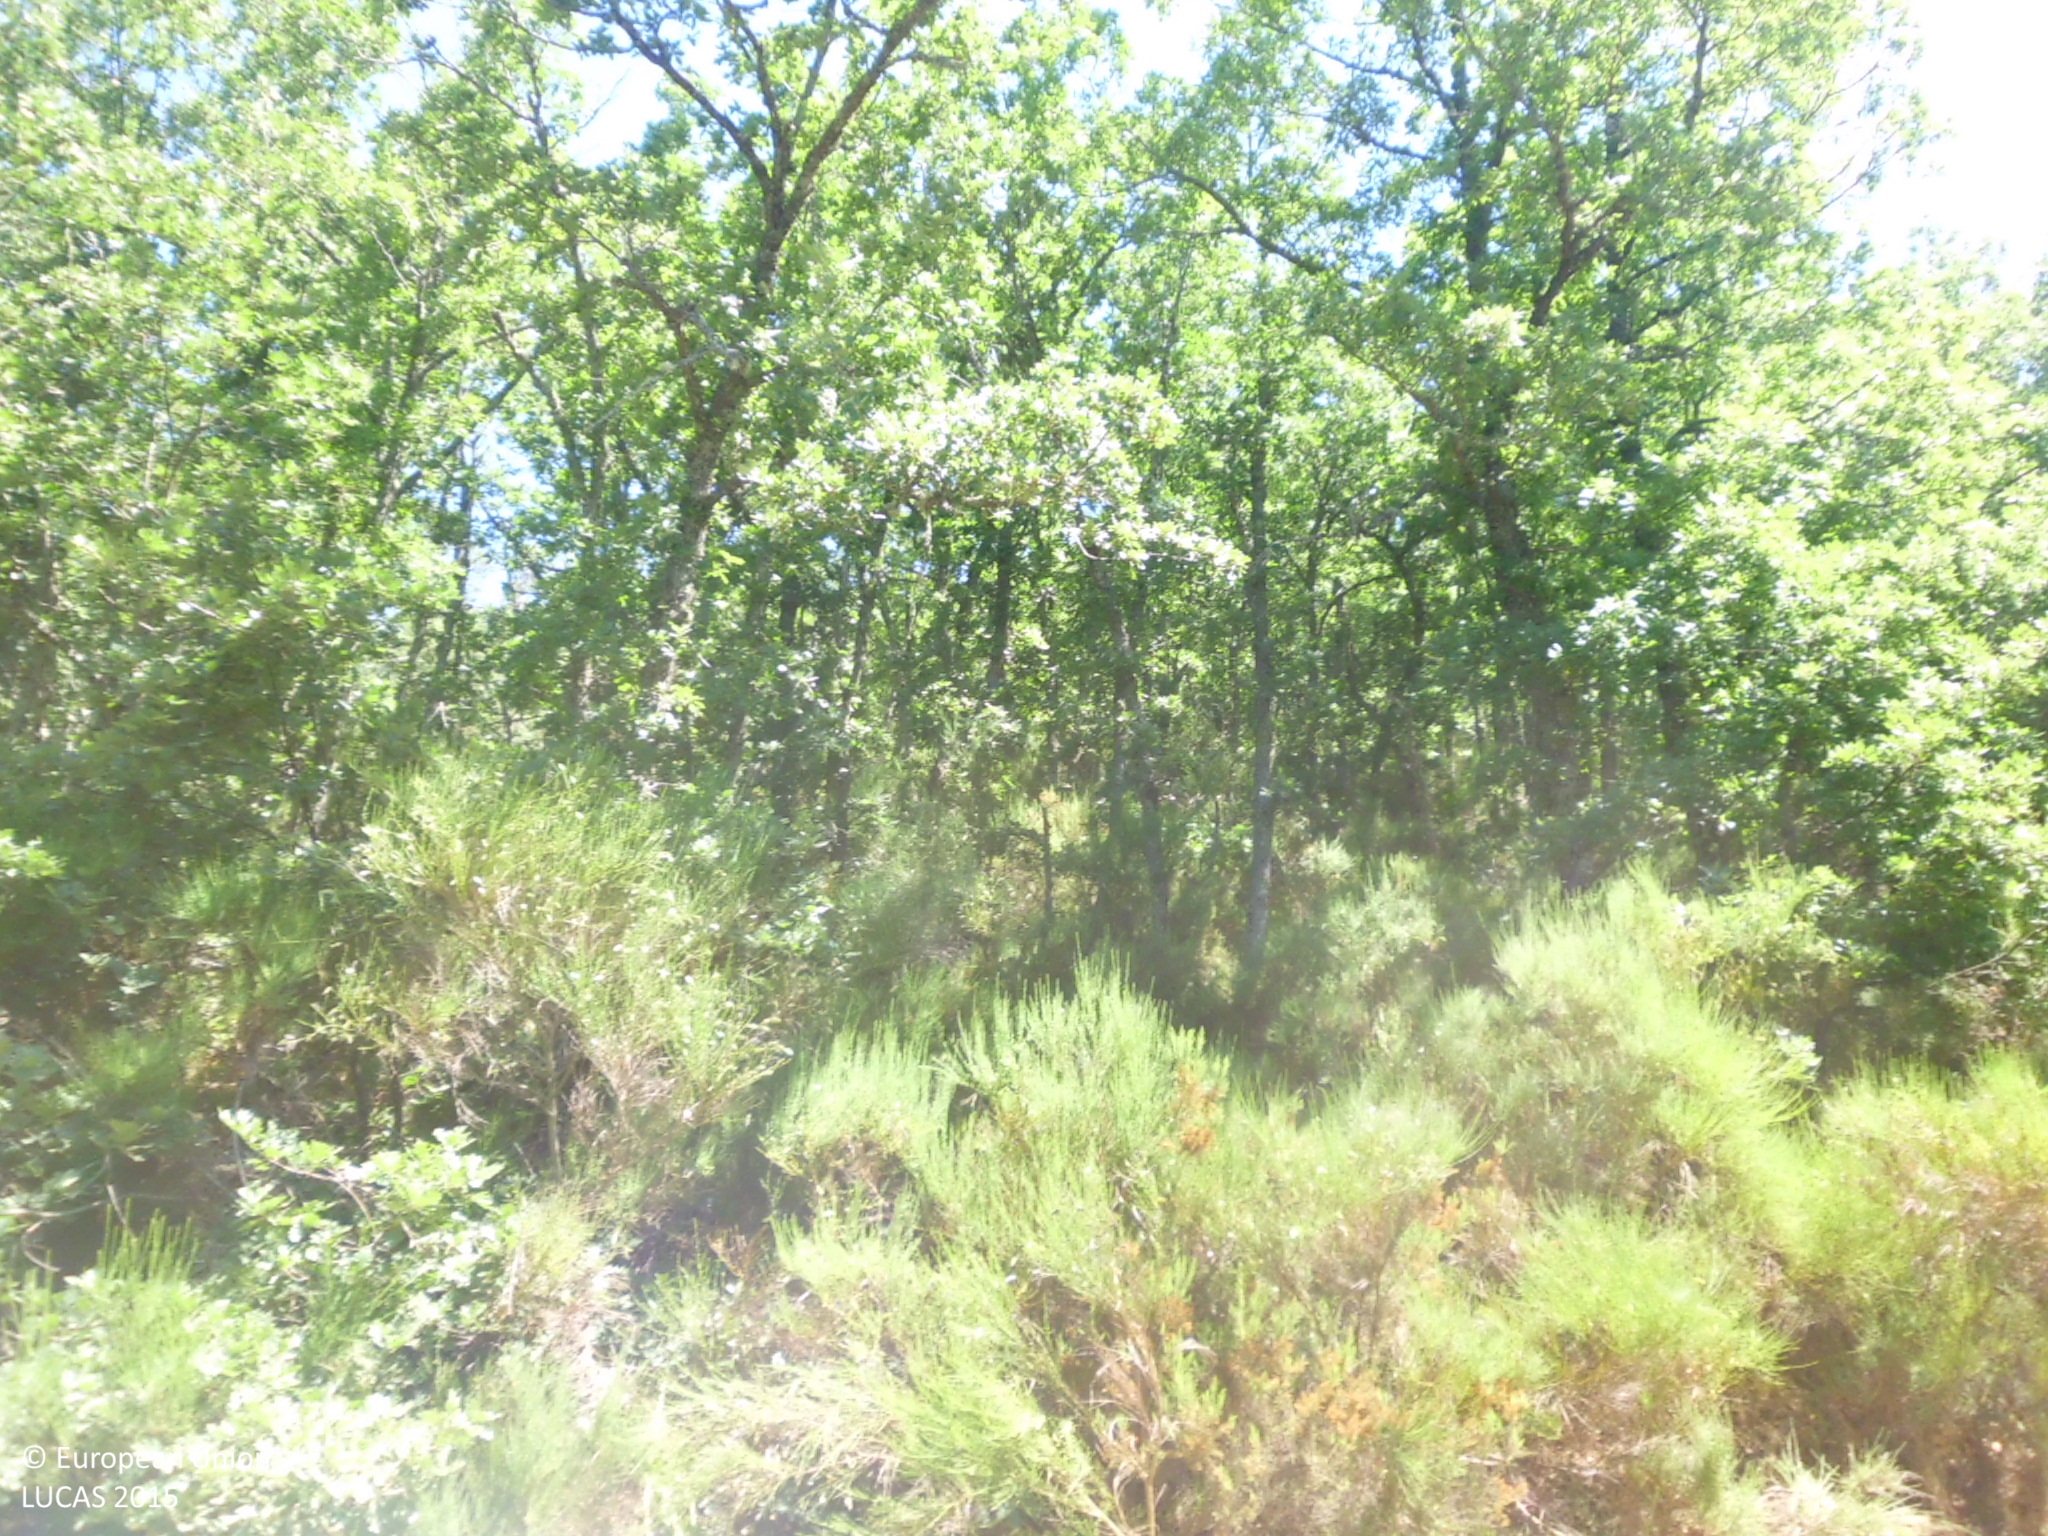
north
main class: Woodland
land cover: Broadleaved woodland
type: acidophilous oak and oak-birch forest
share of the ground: > 75 %
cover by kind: broadleaved forest trees 90 %, shrubs 10 %
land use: Forestry
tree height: > 5 m
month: July
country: ES
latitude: 42.2604
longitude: -3.2052
